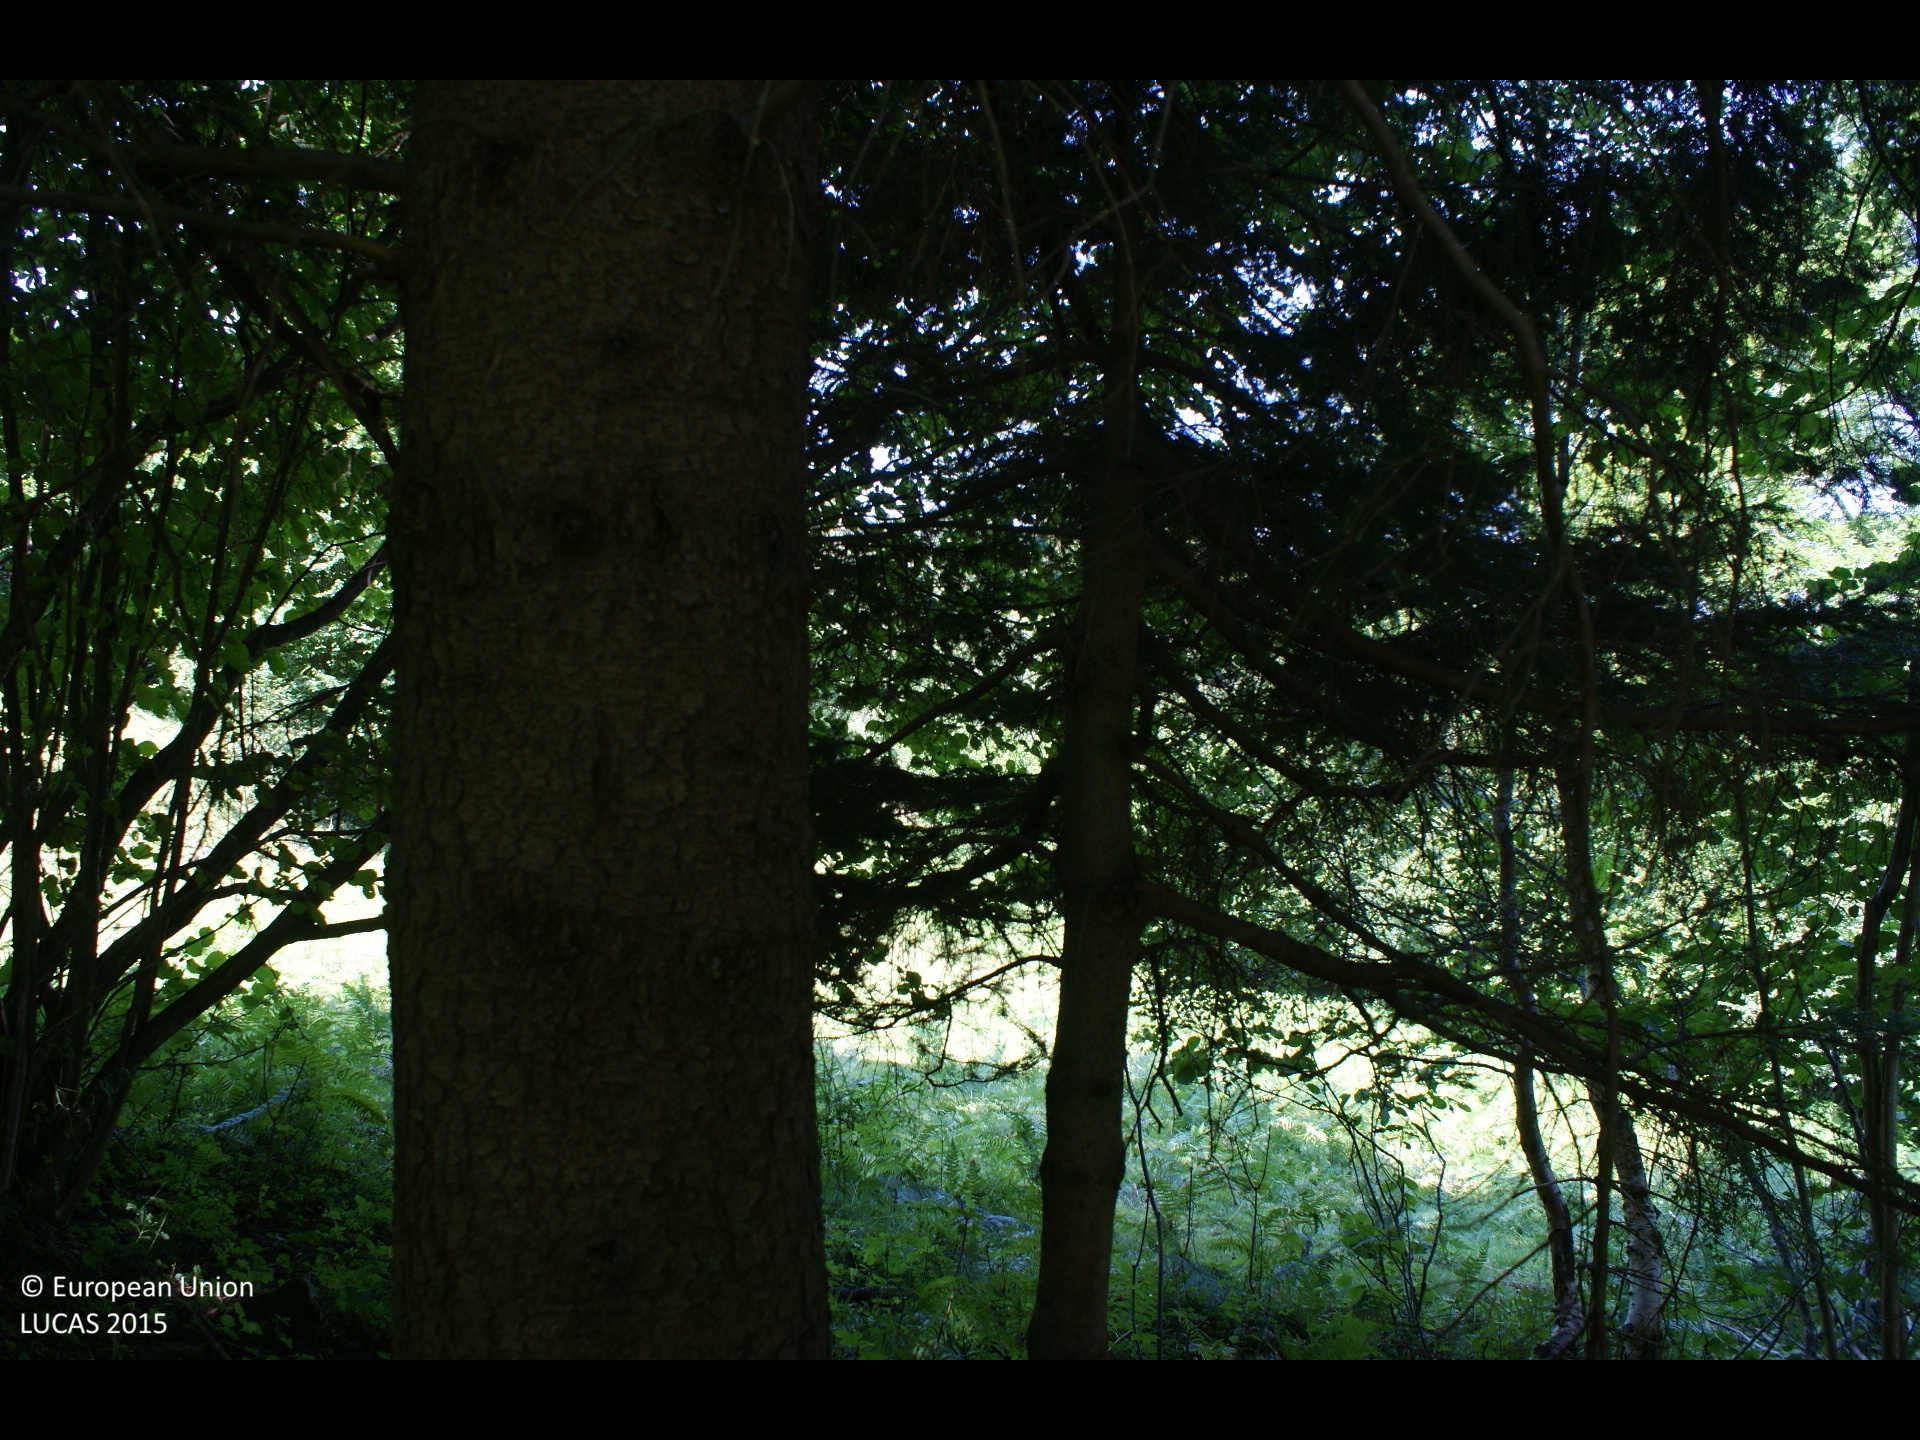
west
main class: Woodland
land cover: Spruce dominated coniferous woodland
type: alpine coniferous forest
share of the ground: > 75 %
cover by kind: coniferous forest trees 70 %, broadleaved forest trees 20 %, shrubs 5 %, herbaceous plants 5 %
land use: Forestry
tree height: > 5 m
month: July
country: AT
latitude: 47.9318
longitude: 15.3421
